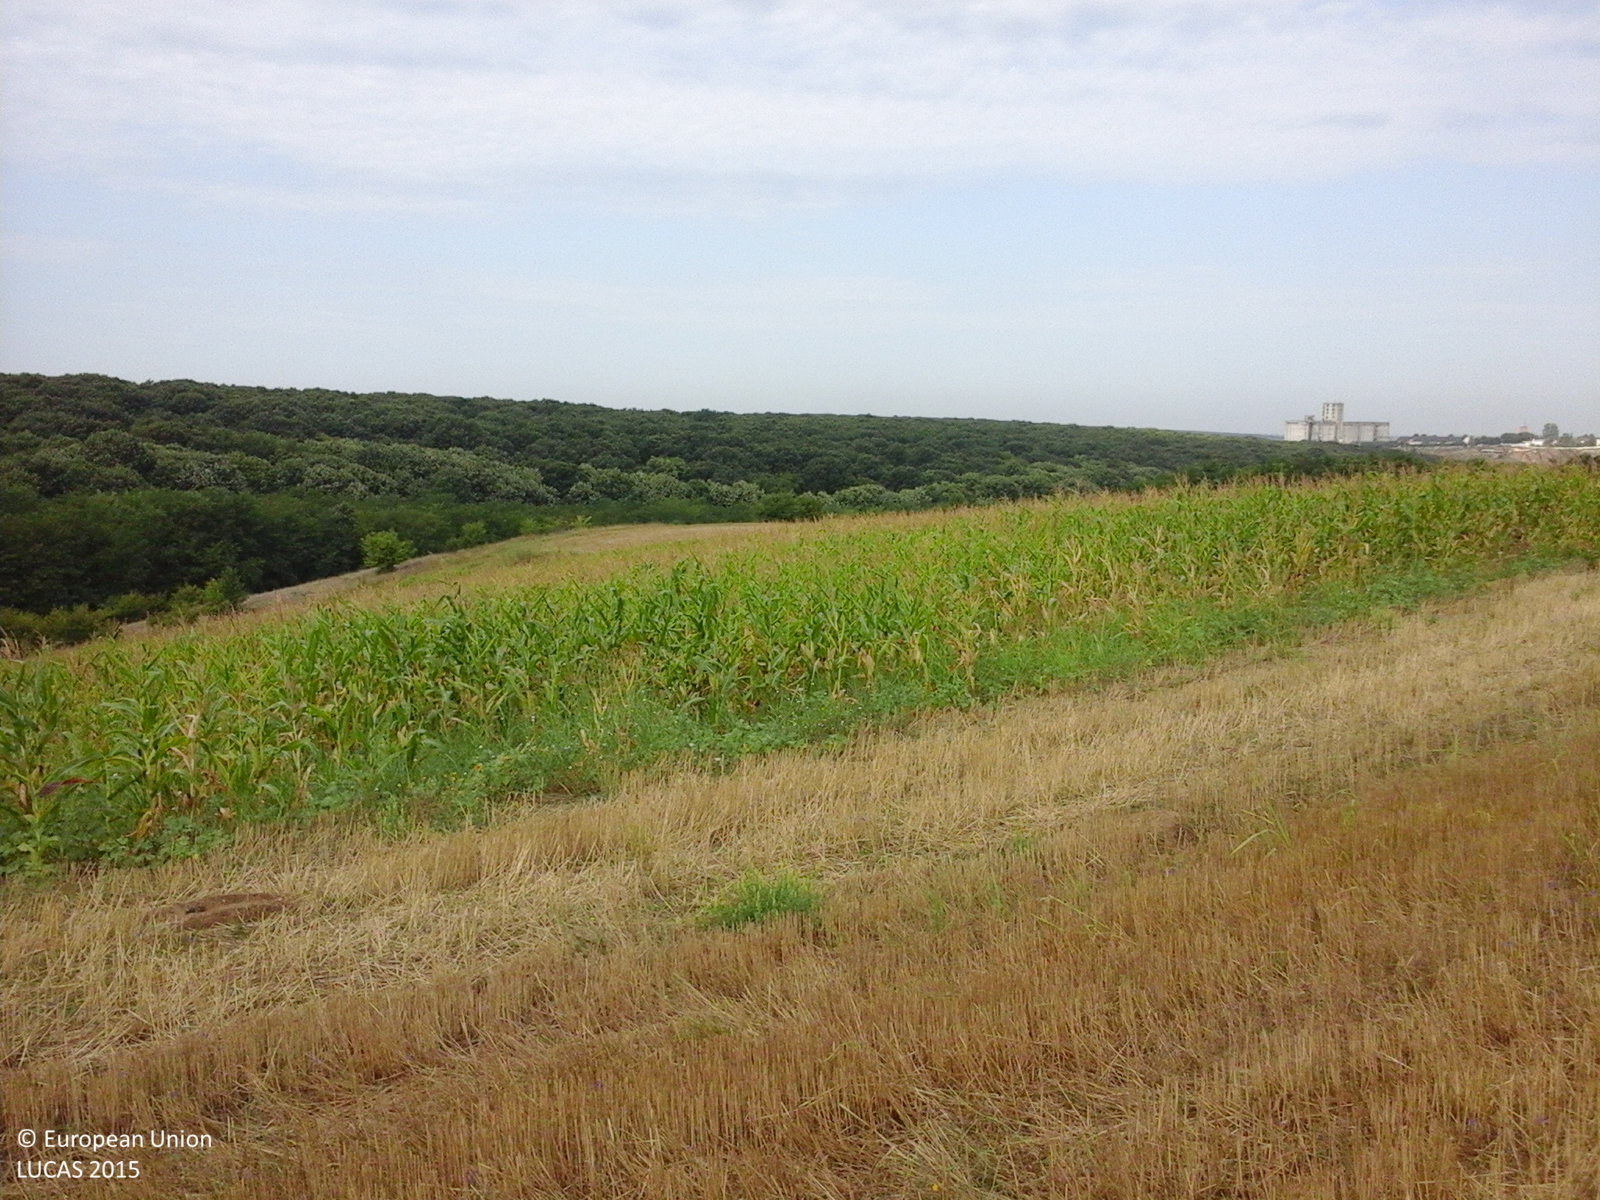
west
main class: Cropland
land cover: Common wheat
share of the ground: > 75 %
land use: Agriculture (excluding fallow land and kitchen gardens)
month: August
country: RO
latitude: 44.0614
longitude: 27.7343
